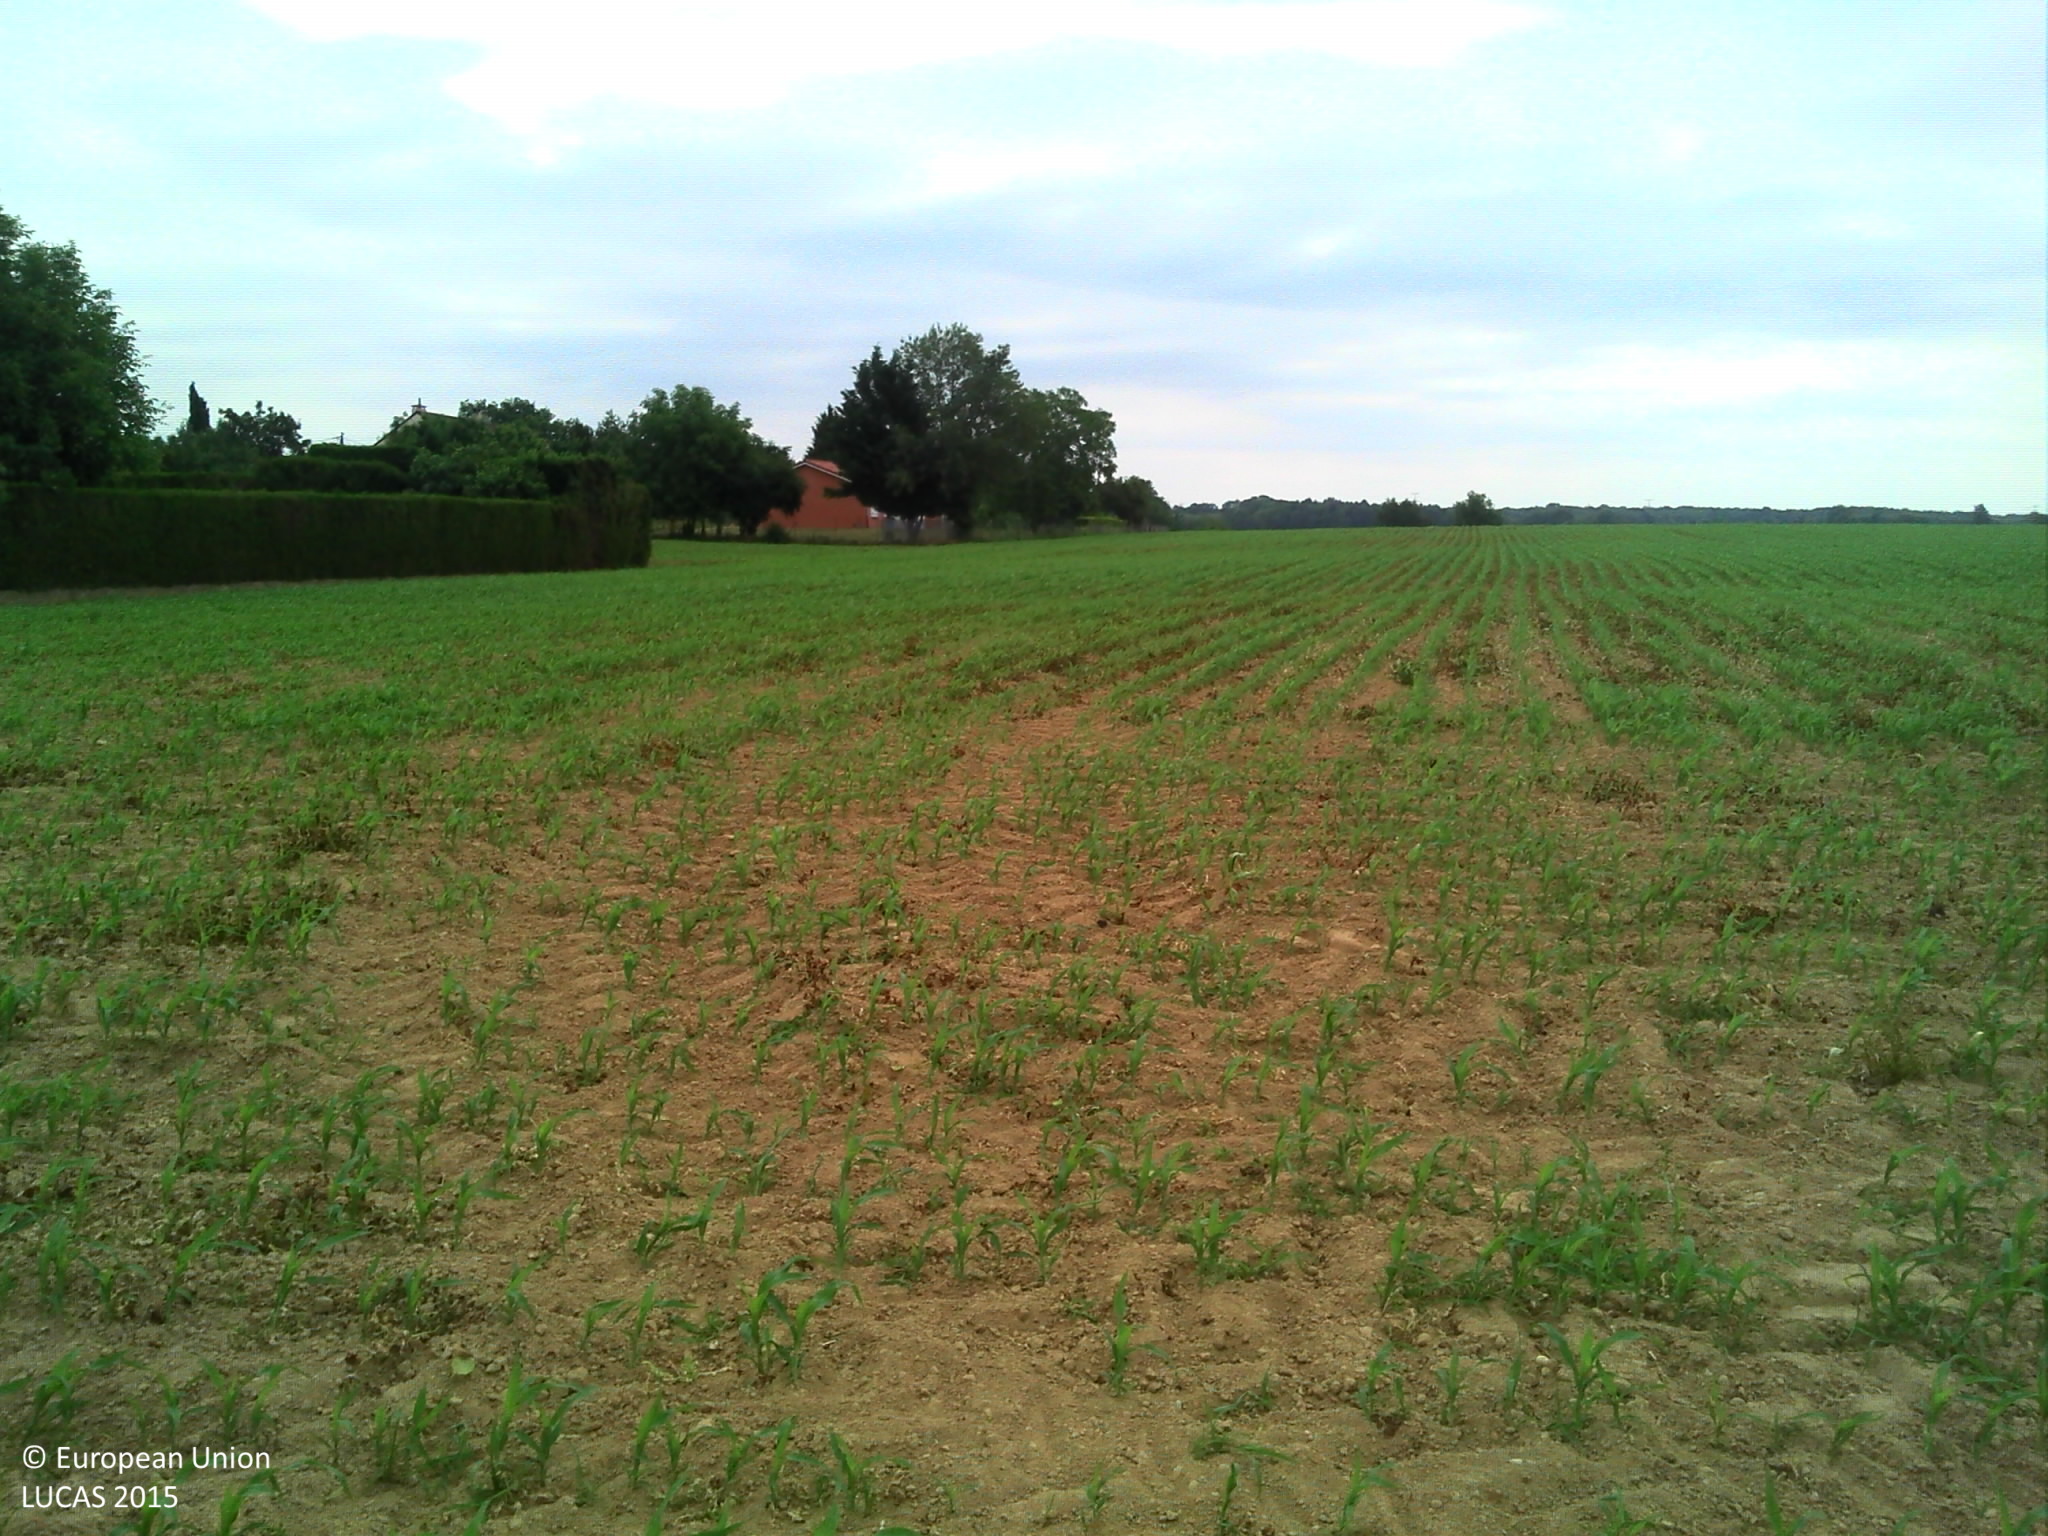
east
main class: Cropland
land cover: Maize
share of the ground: 25 - 50 %
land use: Agriculture (excluding fallow land and kitchen gardens)
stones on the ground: < 10 %
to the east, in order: Maize; Electric lines; Maize; Artificial constructions in urban areas; Maize
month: June
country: FR
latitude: 46.1351
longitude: 4.8121
